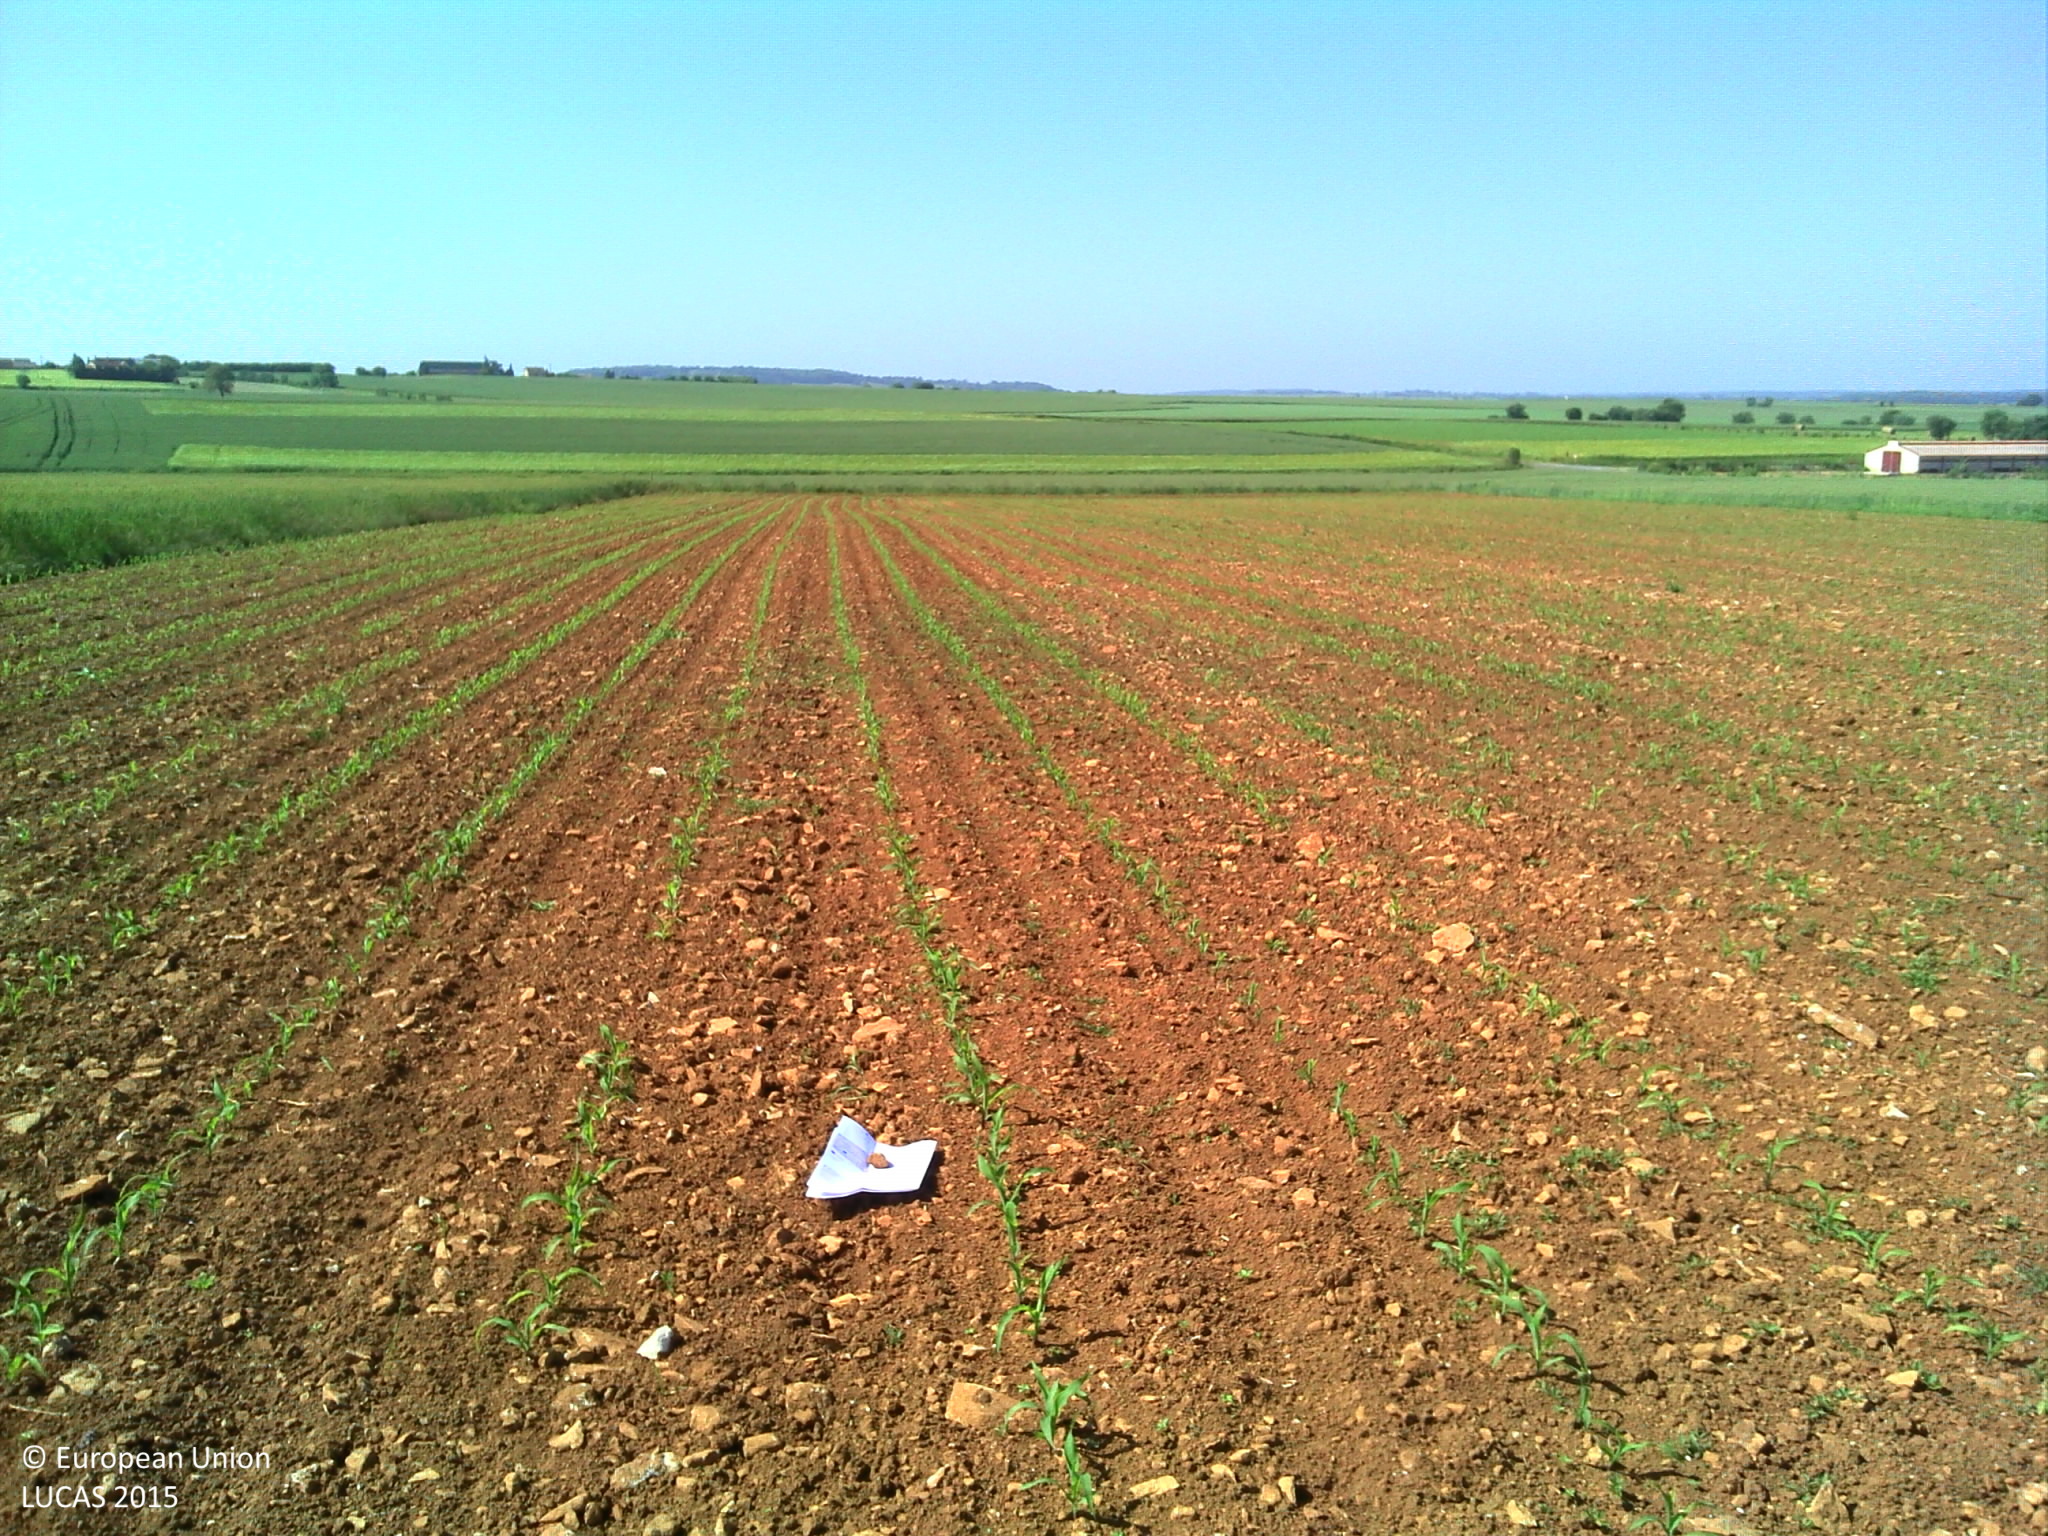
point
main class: Cropland
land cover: Maize
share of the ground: < 10 %
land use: Agriculture (excluding fallow land and kitchen gardens)
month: June
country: FR
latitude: 48.1115
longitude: -0.0080
